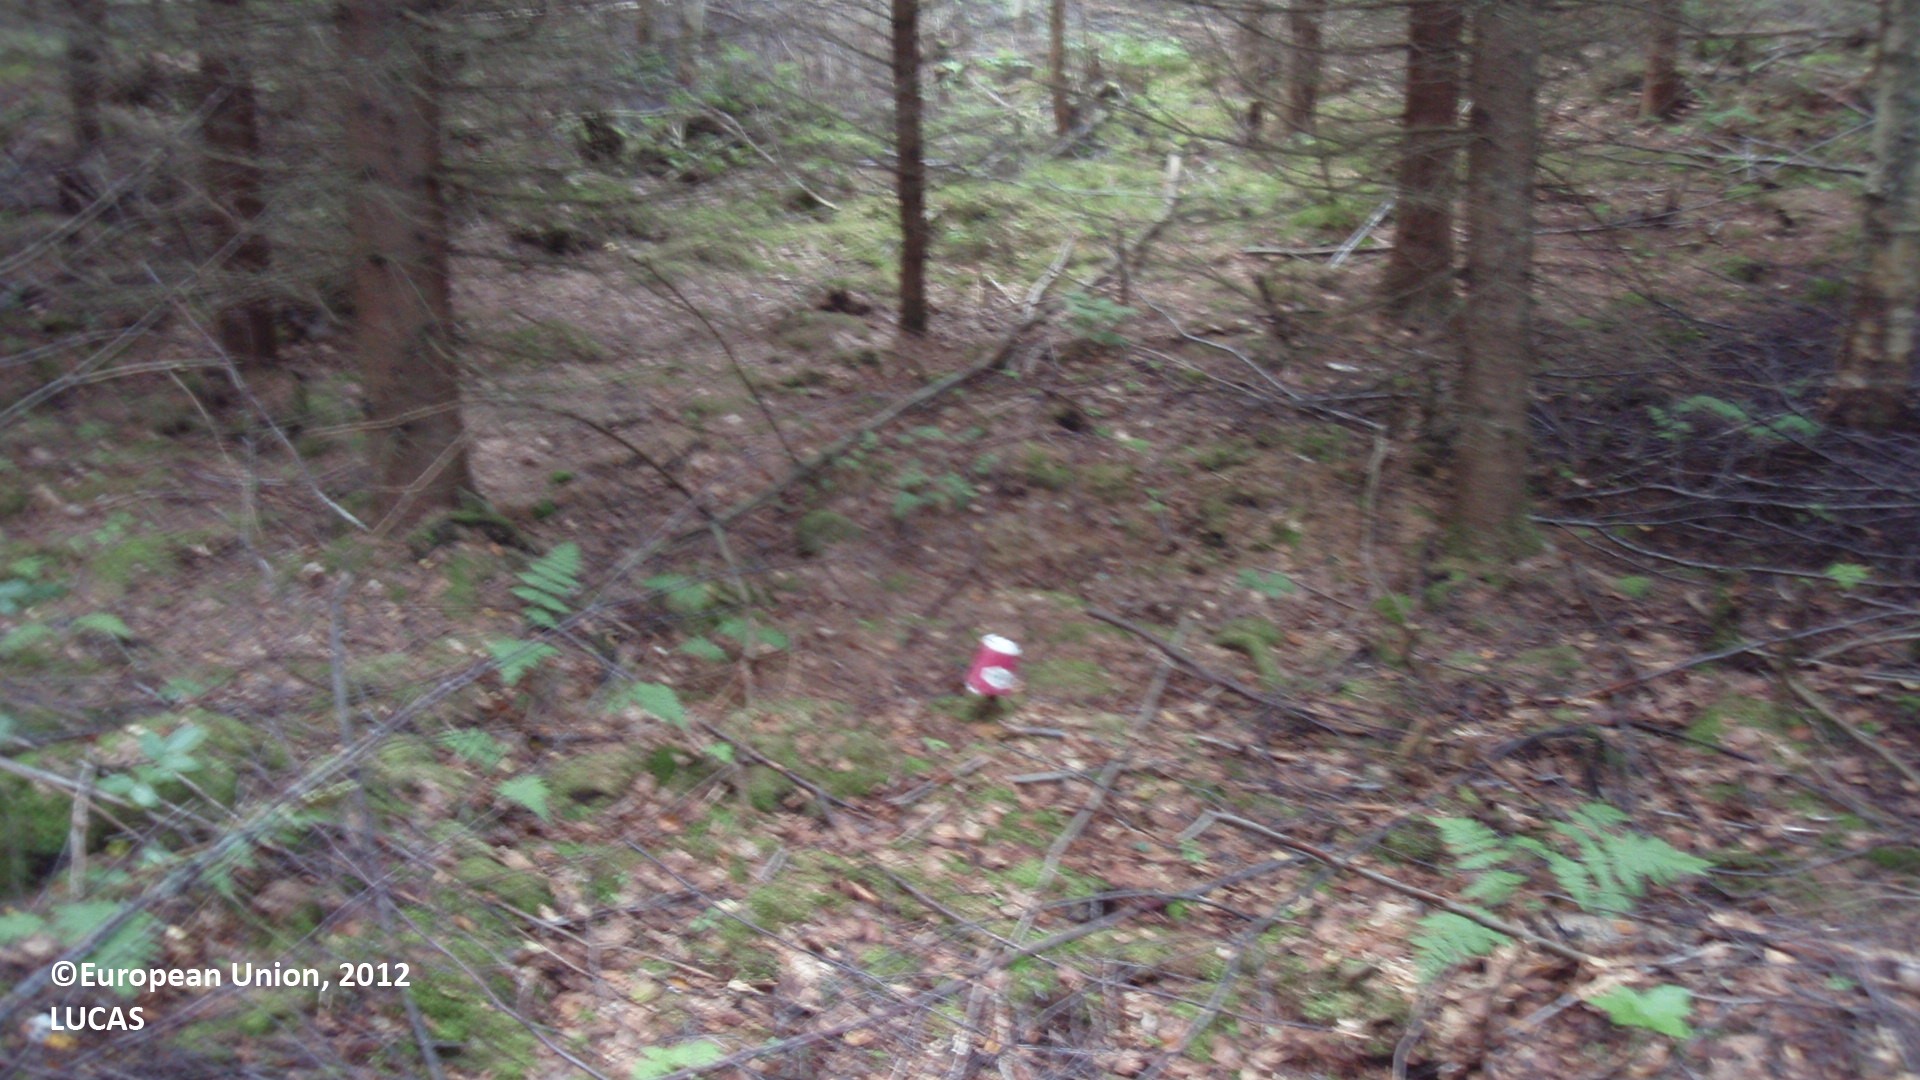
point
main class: Woodland
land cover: Spruce dominated mixed woodland
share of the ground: > 75 %
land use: Forestry
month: August
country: FI
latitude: 61.3060
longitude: 27.7183
